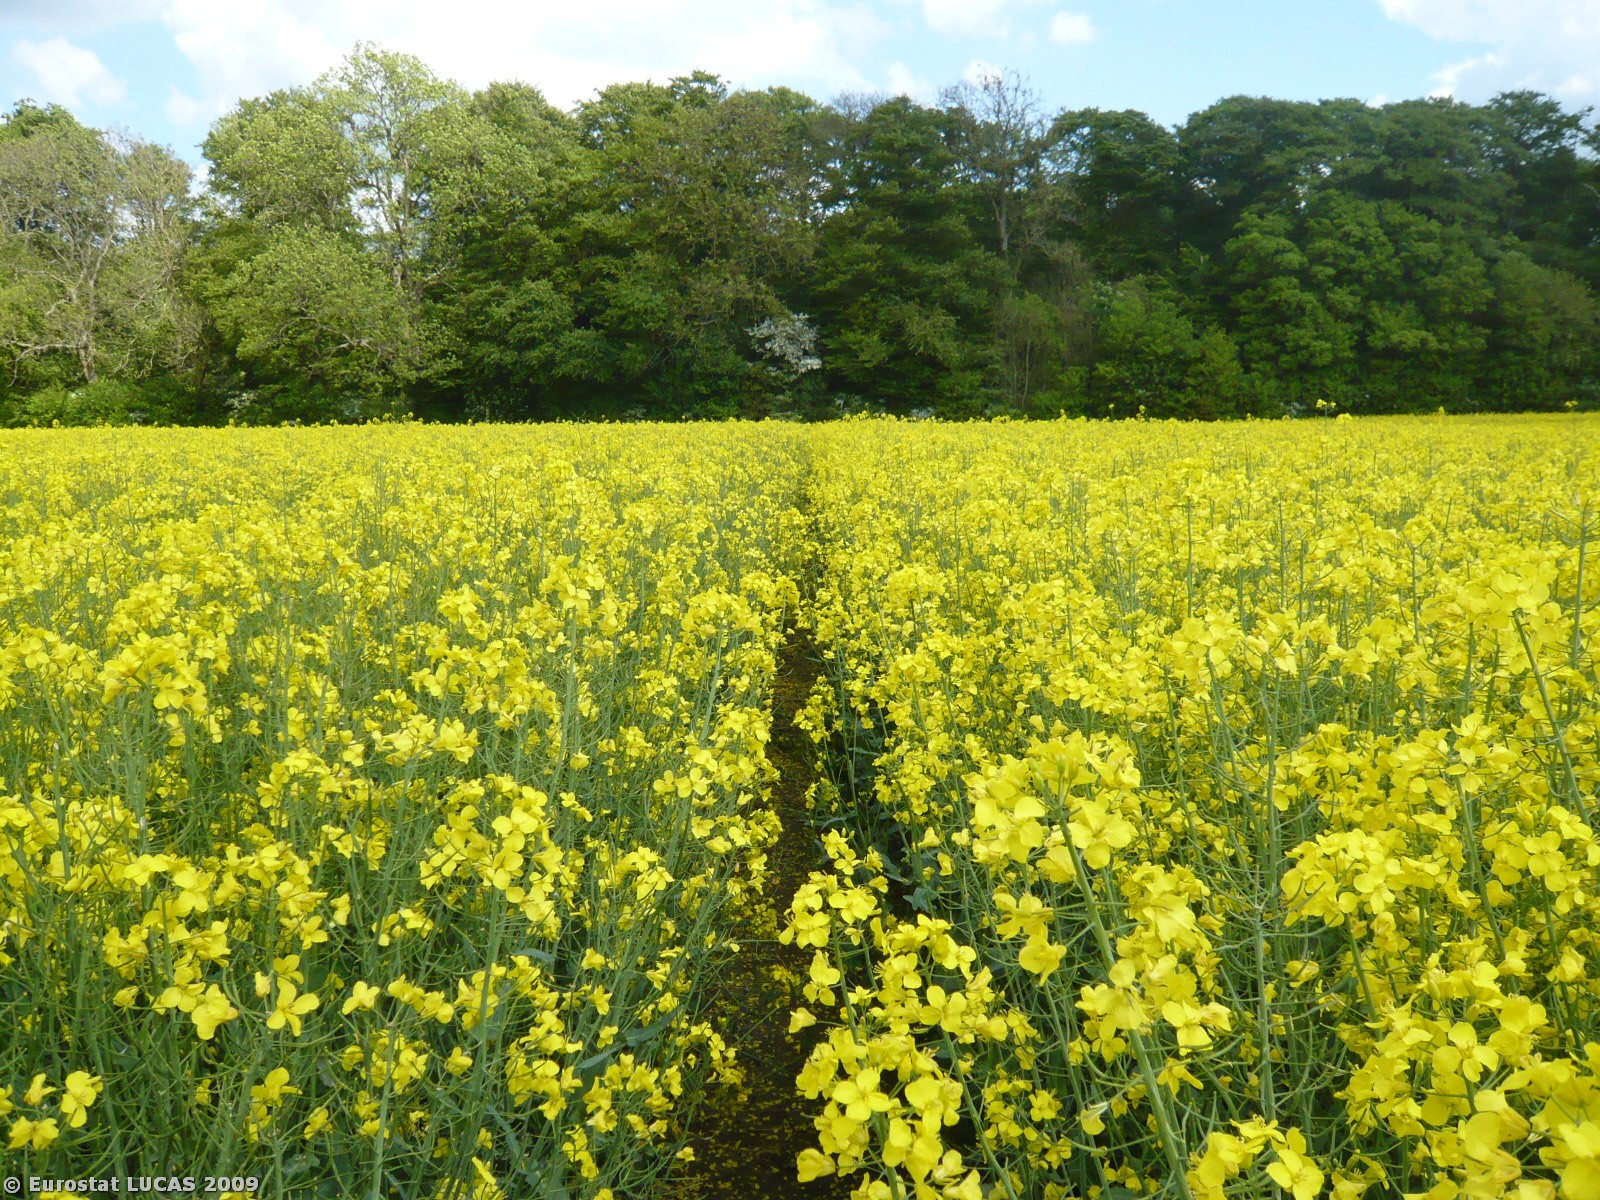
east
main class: Cropland
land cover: Rape and turnip rape
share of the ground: > 75 %
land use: Agriculture (excluding fallow land and kitchen gardens)
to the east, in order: Rape and turnip rape; Broadleaved woodland; Paved roads, cycling and walking lanes; Broadleaved woodland; Ditches and canals; Broadleaved woodland
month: May
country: DK
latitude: 55.4154
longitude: 12.0993
